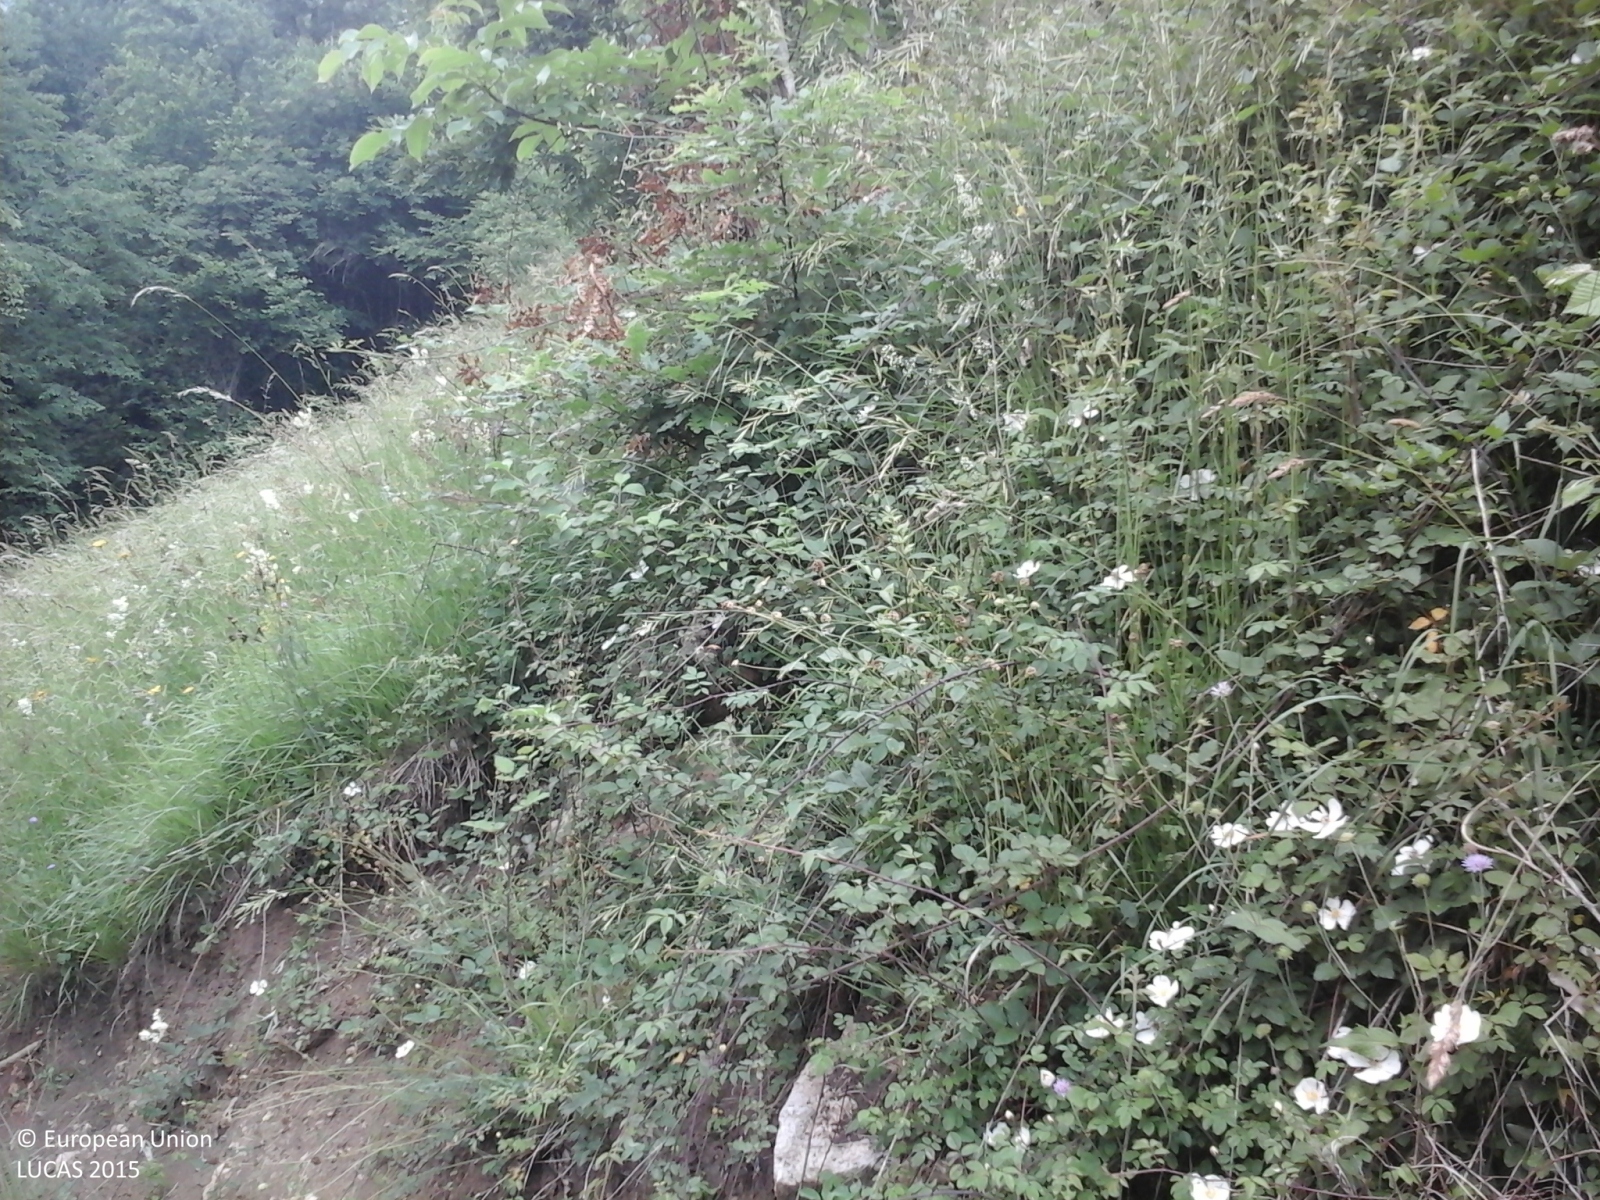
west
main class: Grassland
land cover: Grassland without tree/shrub cover
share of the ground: > 75 %
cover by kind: herbaceous plants 100 %
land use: Agriculture (excluding fallow land and kitchen gardens)
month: June
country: IT
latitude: 45.6840
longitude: 10.3461
